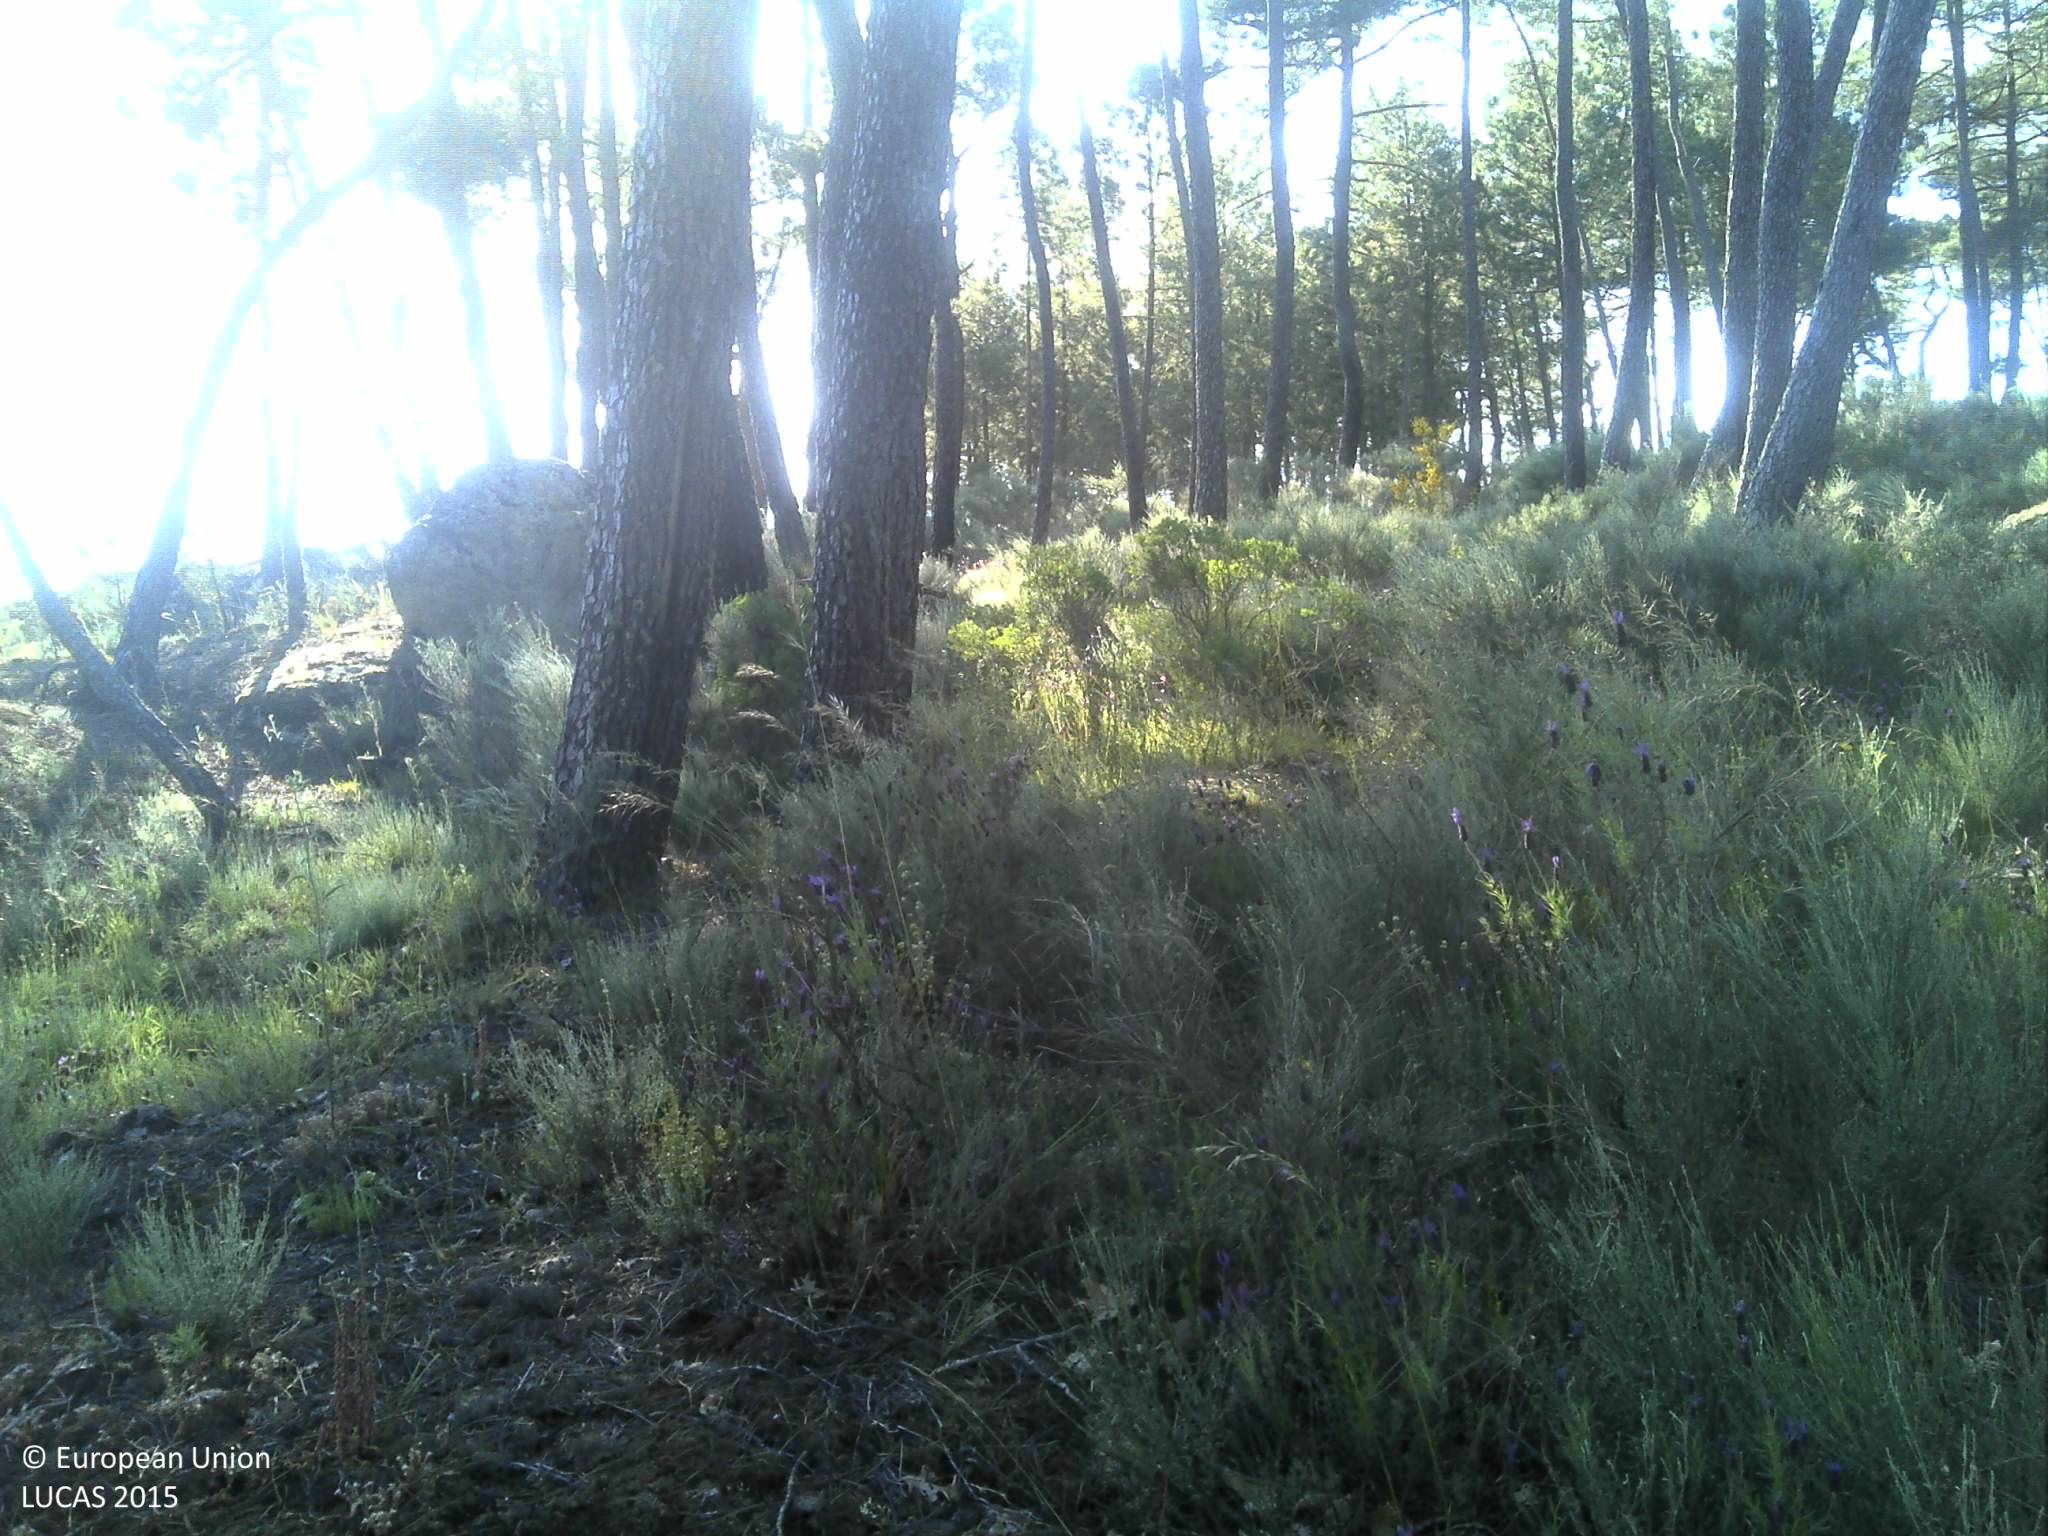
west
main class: Woodland
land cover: Pine dominated coniferous woodland
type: coniferous forest of the mediterranean region
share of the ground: 25 - 50 %
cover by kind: coniferous forest trees 60 %, shrubs 10 %, herbaceous plants 10 %, unconsolidated bare surface 10 %
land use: Forestry
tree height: > 5 m
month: May
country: PT
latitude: 40.7245
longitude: -7.2155
